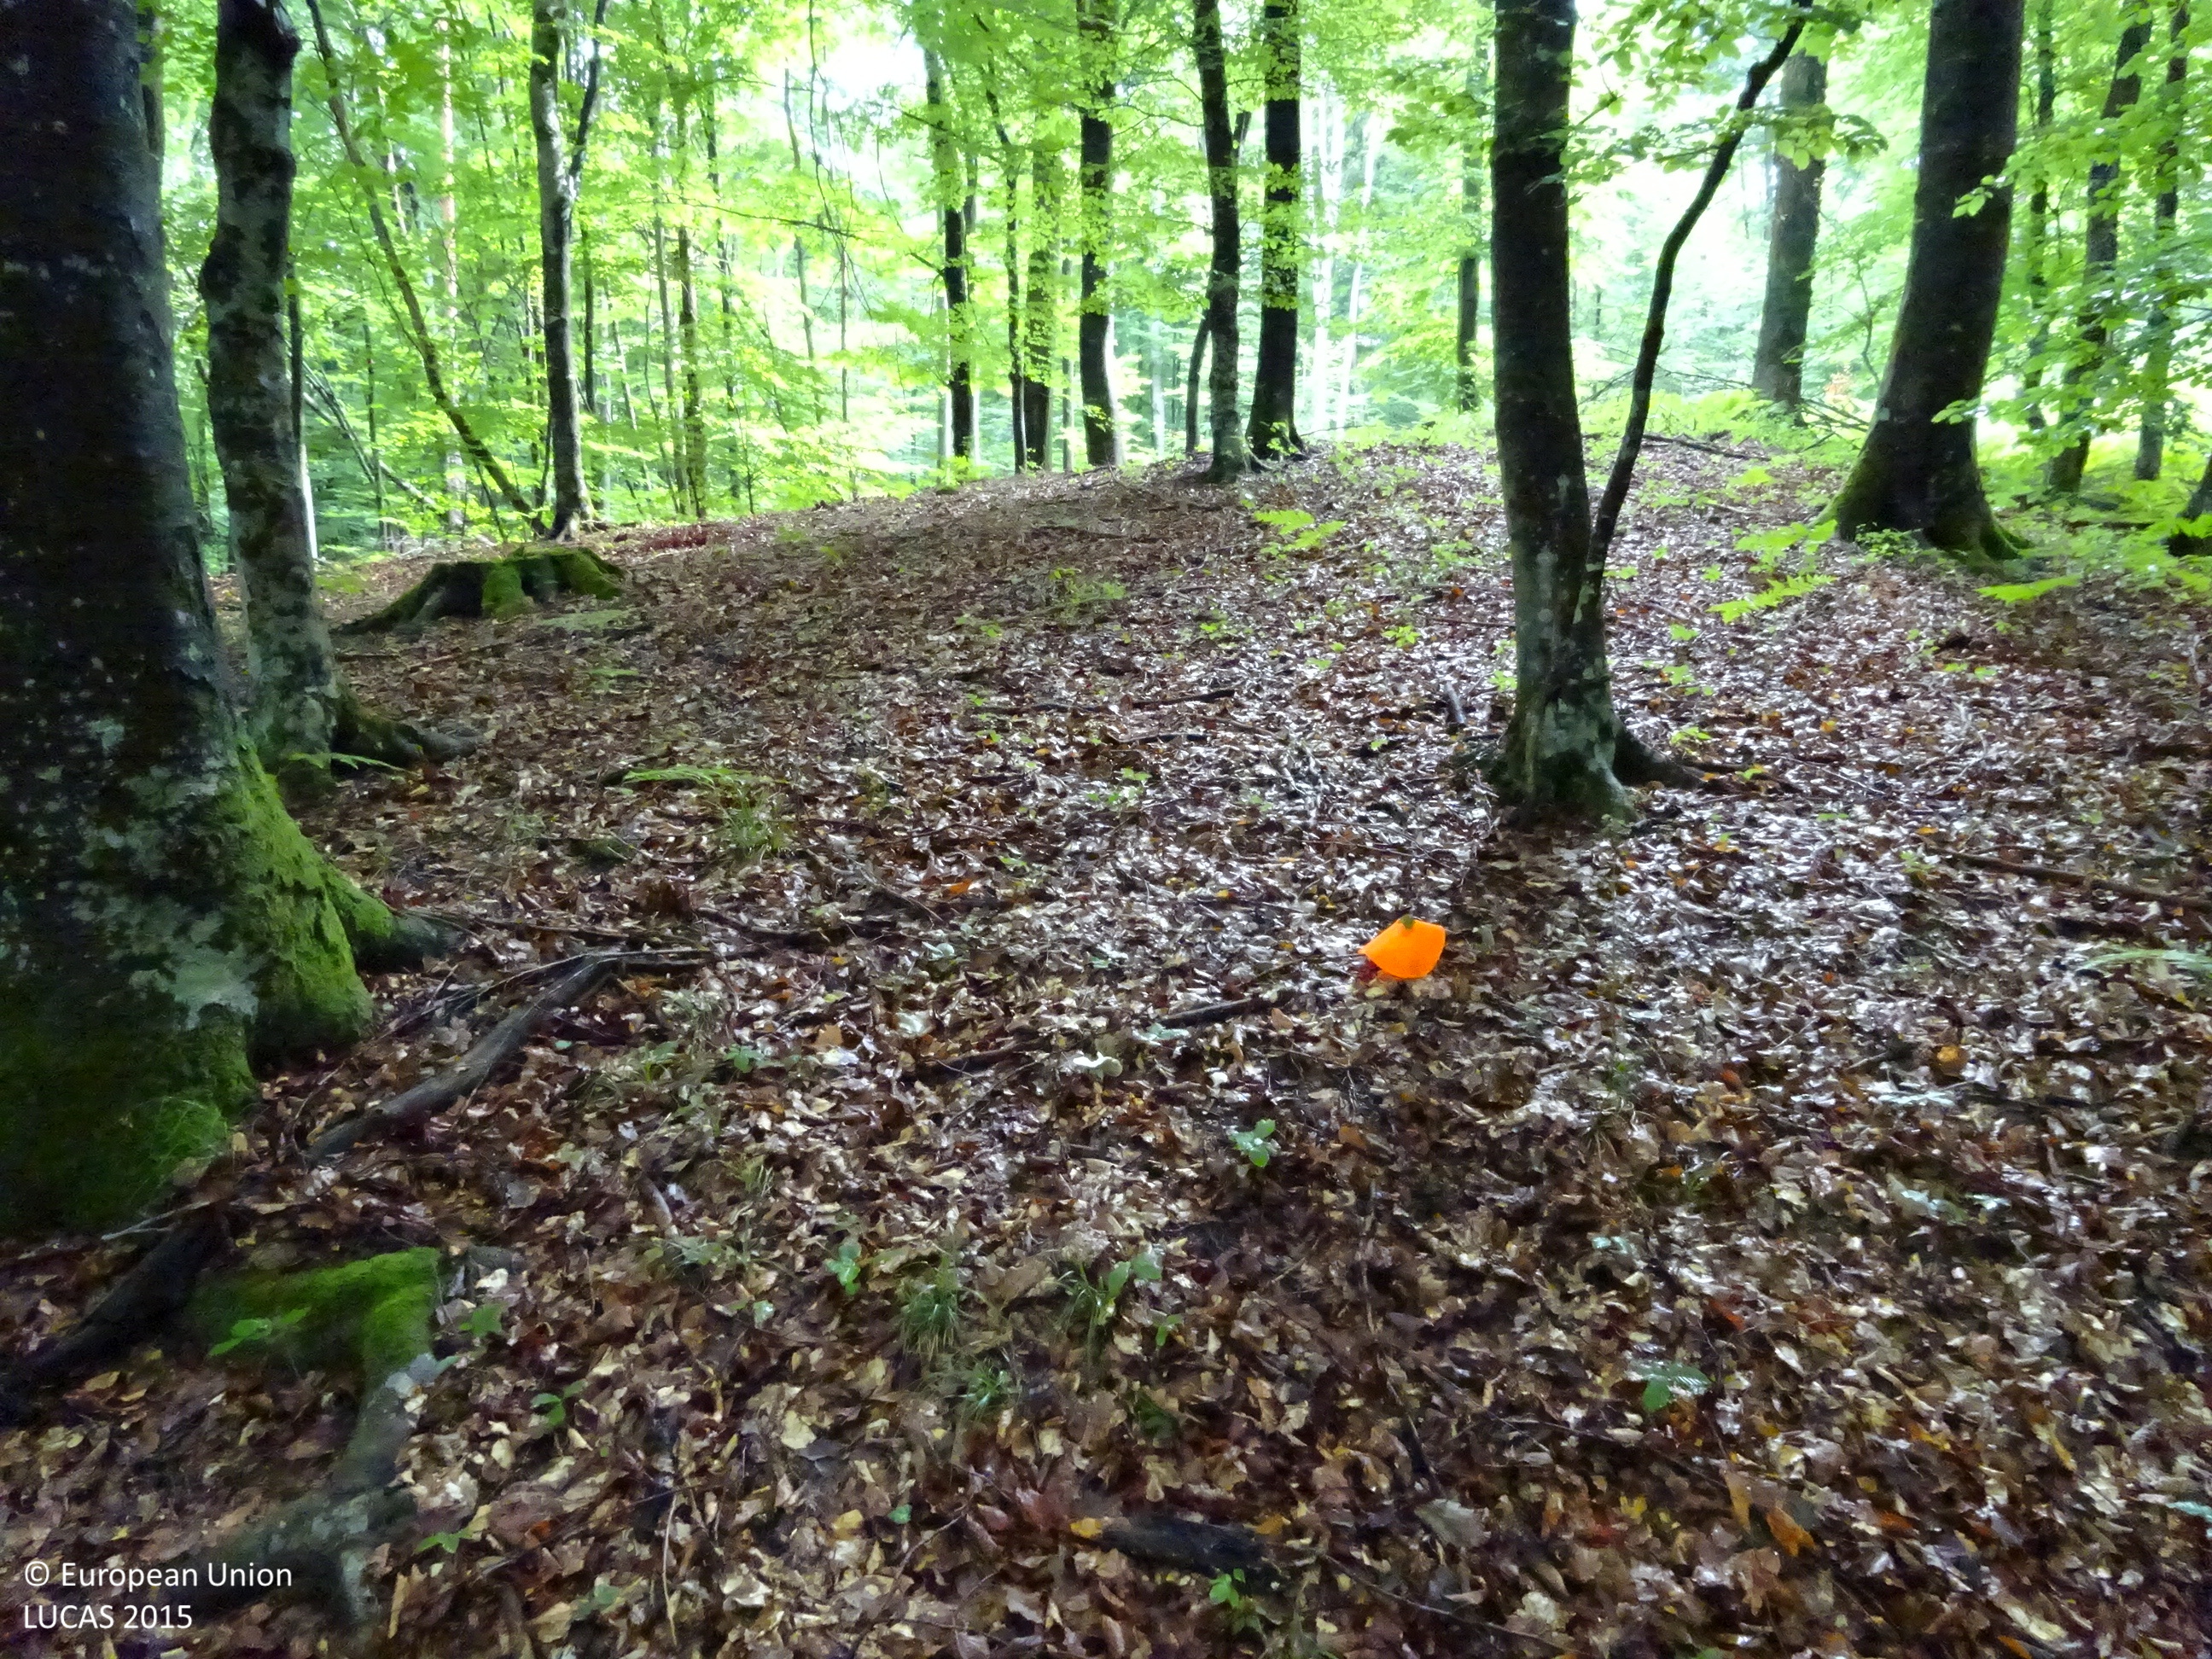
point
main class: Woodland
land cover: Broadleaved woodland
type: mountainous beech forest
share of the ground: > 75 %
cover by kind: broadleaved forest trees 90 %, unconsolidated bare surface 10 %
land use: Forestry
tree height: > 5 m
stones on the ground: < 10 %
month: June
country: AT
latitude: 46.7008
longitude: 15.4266
